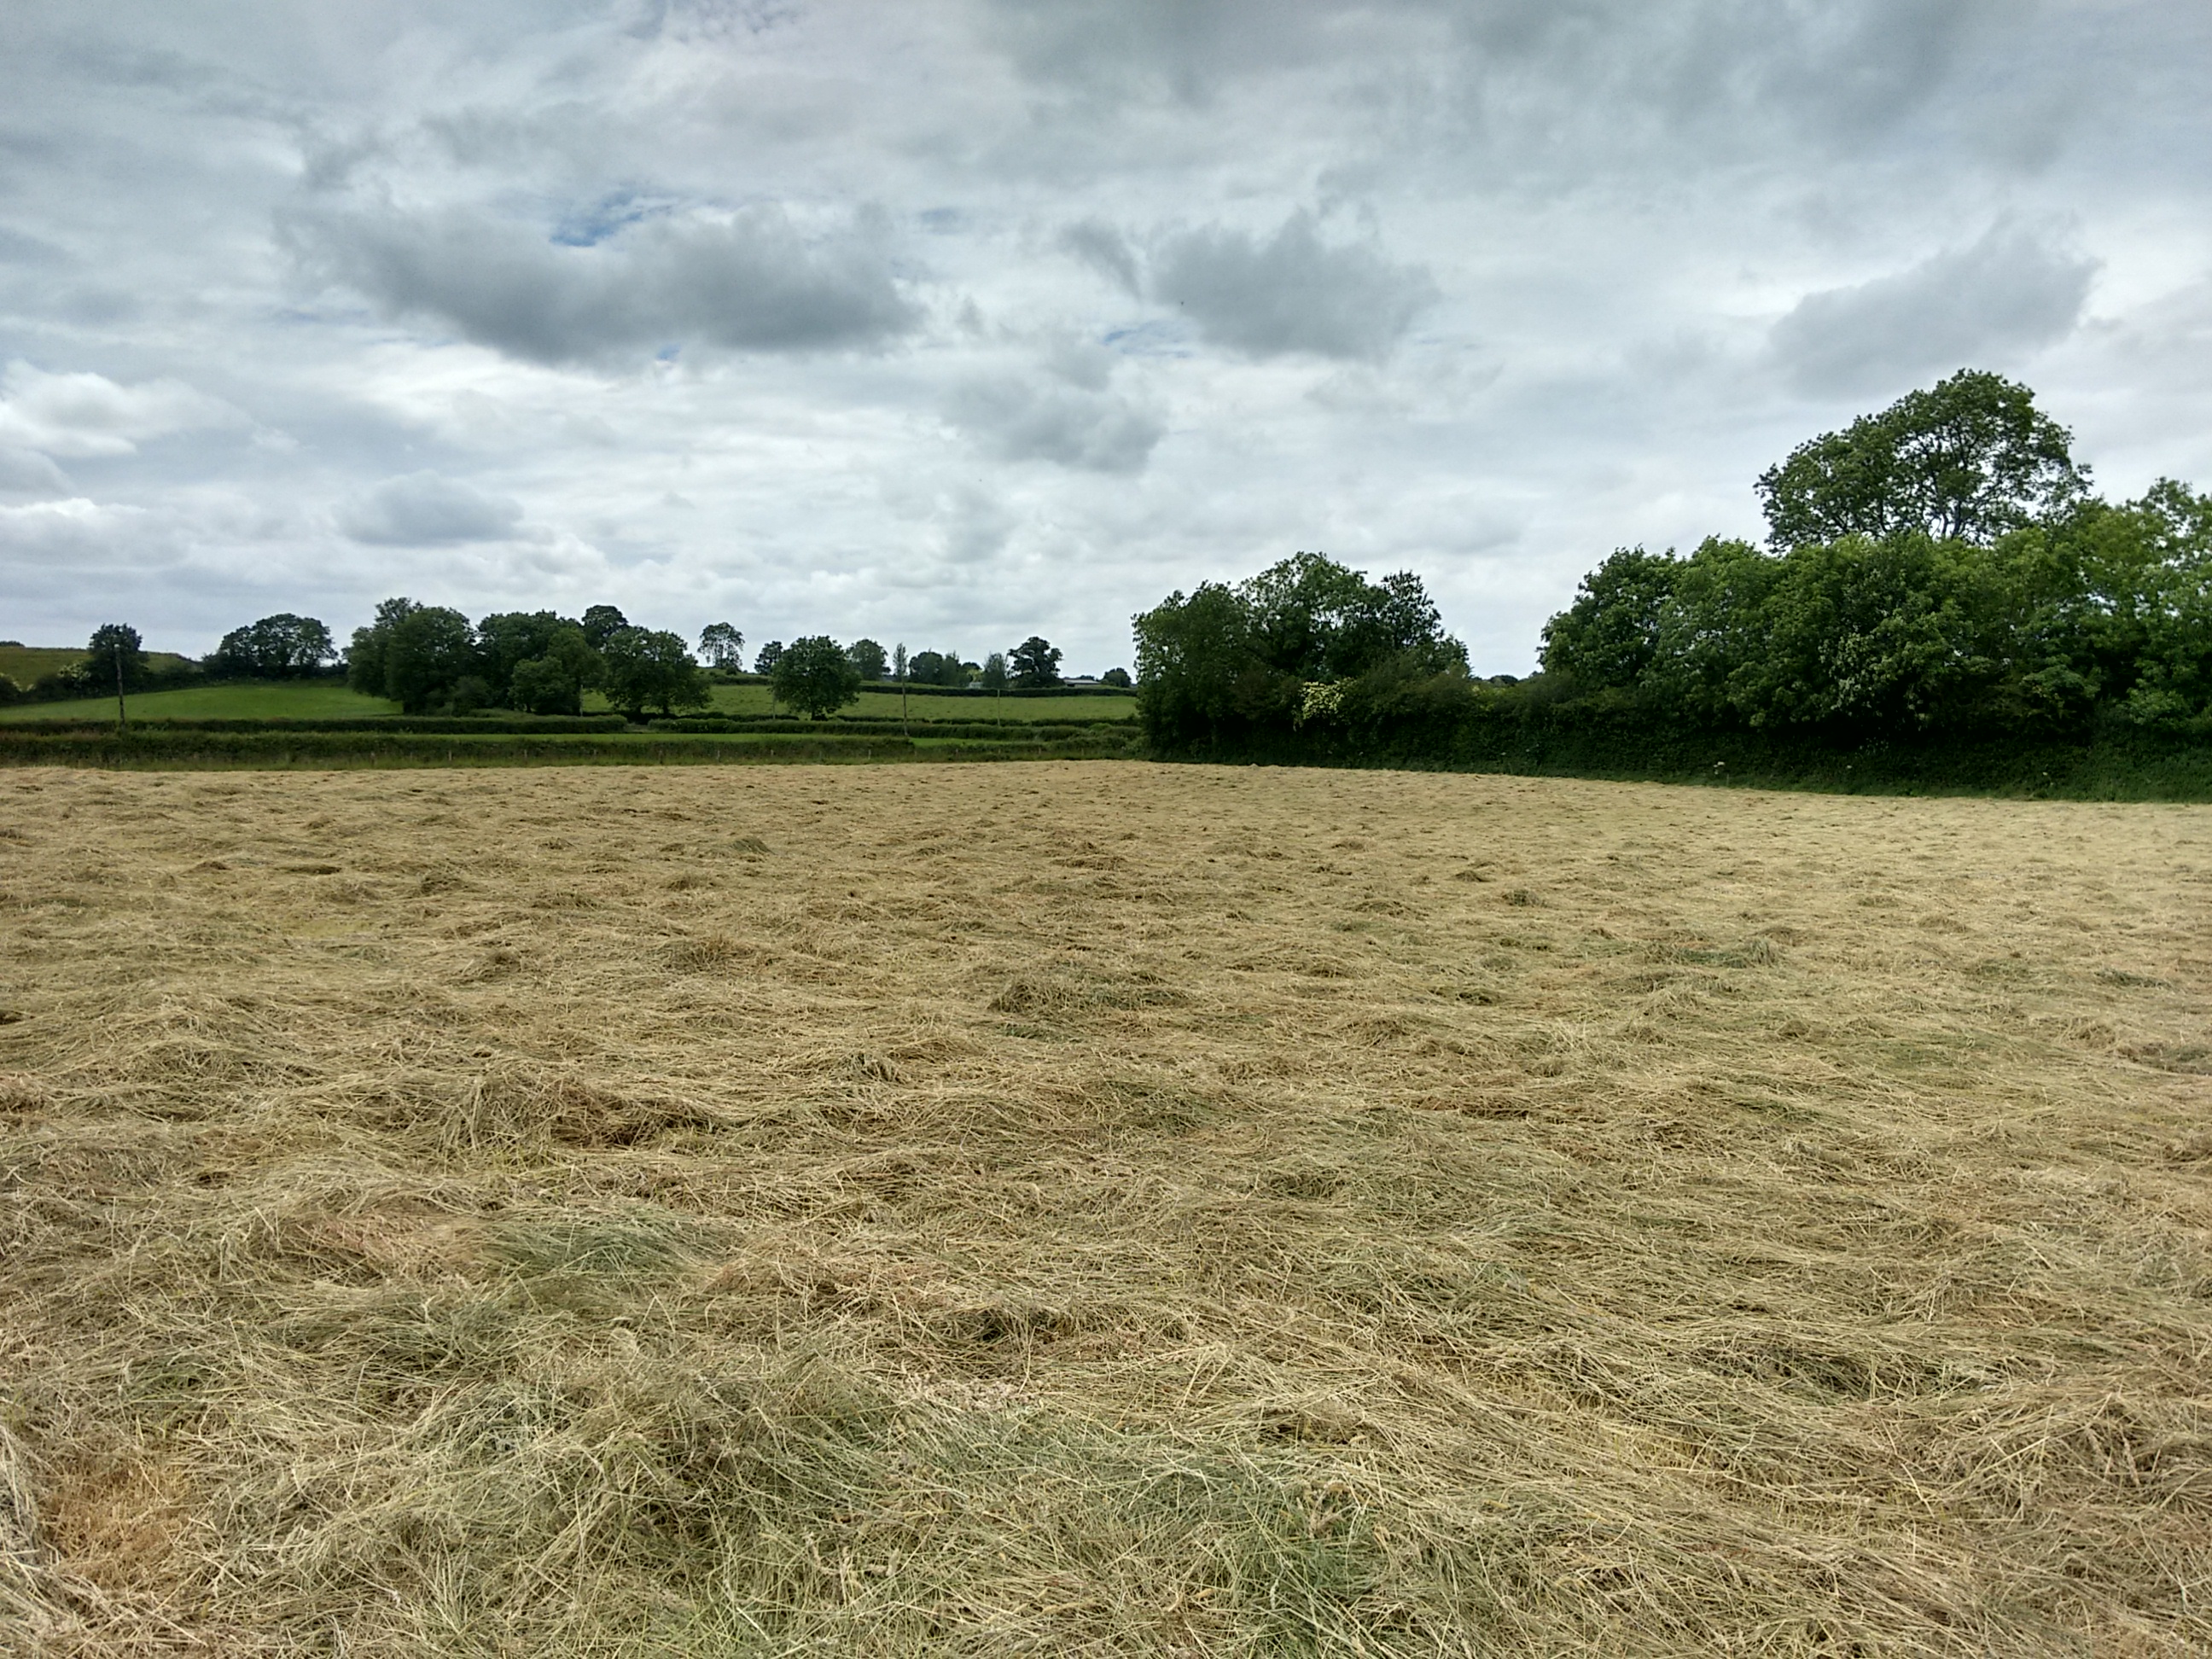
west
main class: Grassland
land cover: Grassland without tree/shrub cover
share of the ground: > 75 %
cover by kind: herbaceous plants 95 %, consolidated bare surface 5 %
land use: Agriculture (excluding fallow land and kitchen gardens)
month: June
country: IE
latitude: 53.4201
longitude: -7.6323
